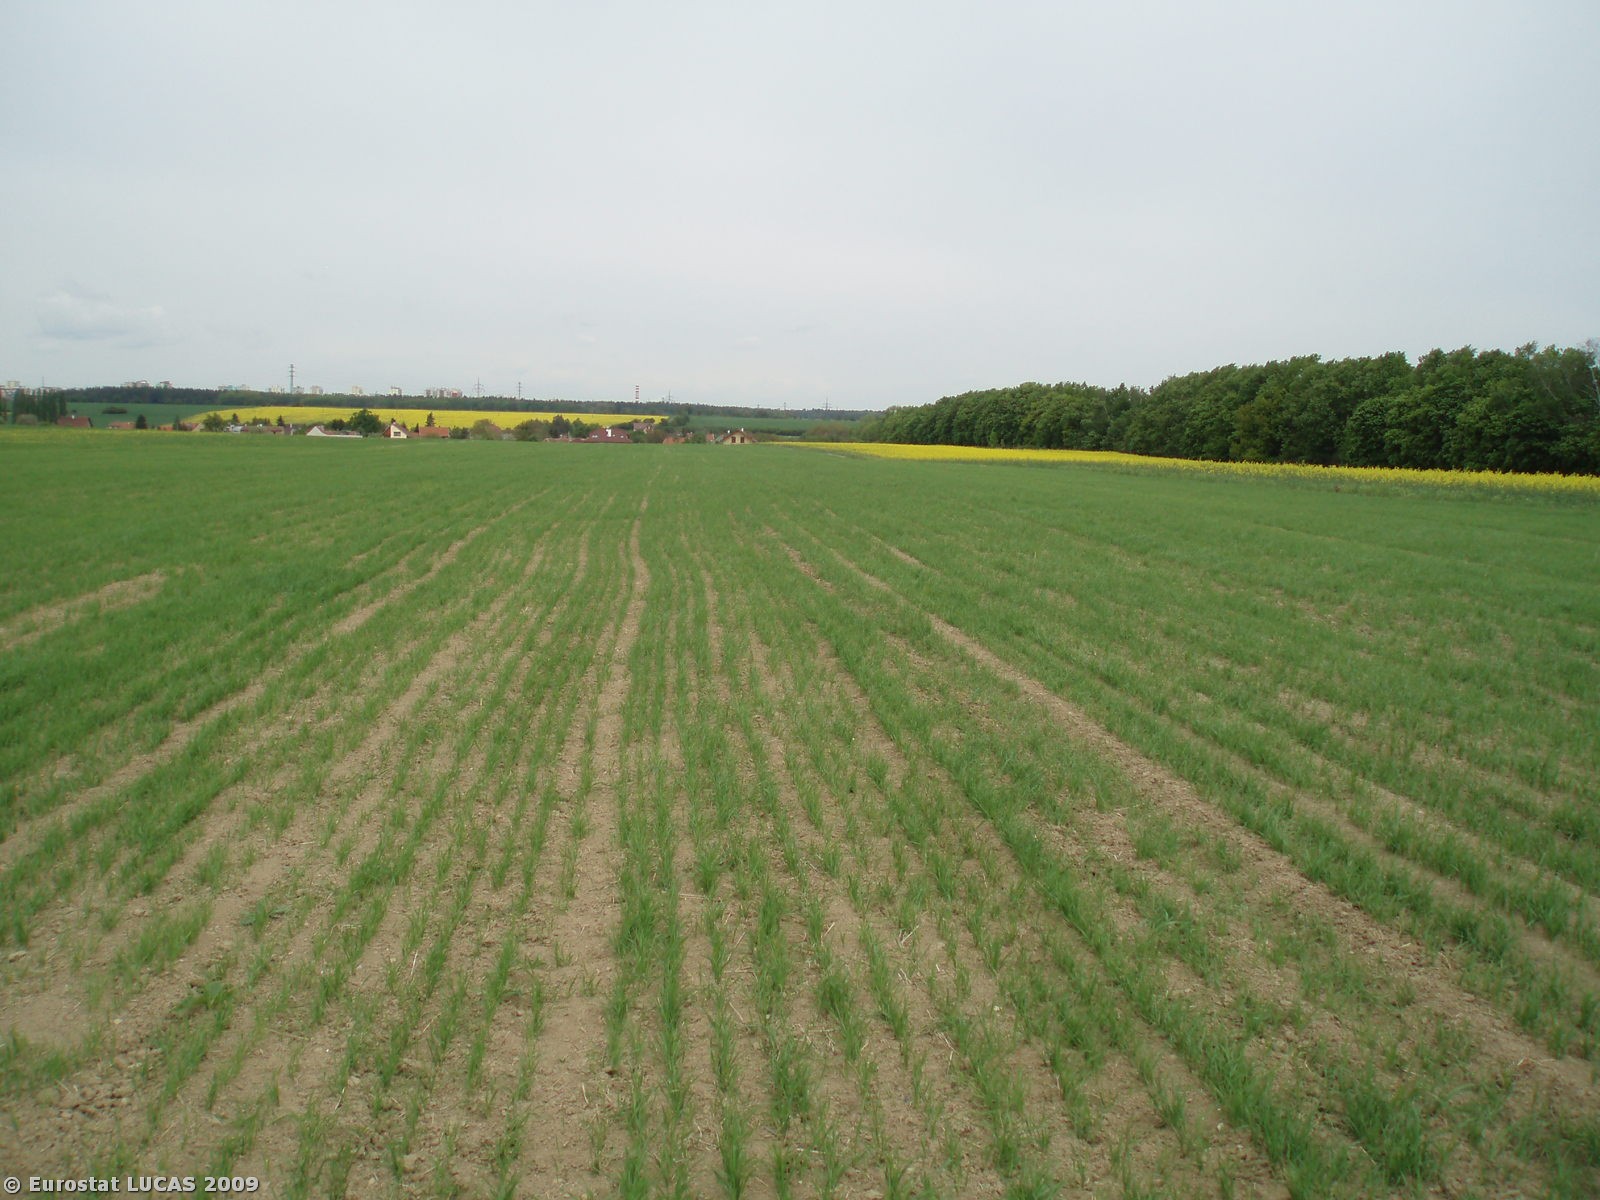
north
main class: Cropland
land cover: Common wheat
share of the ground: 50 - 75 %
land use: Agriculture (excluding fallow land and kitchen gardens)
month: May
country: CZ
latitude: 50.1086
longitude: 14.1540
